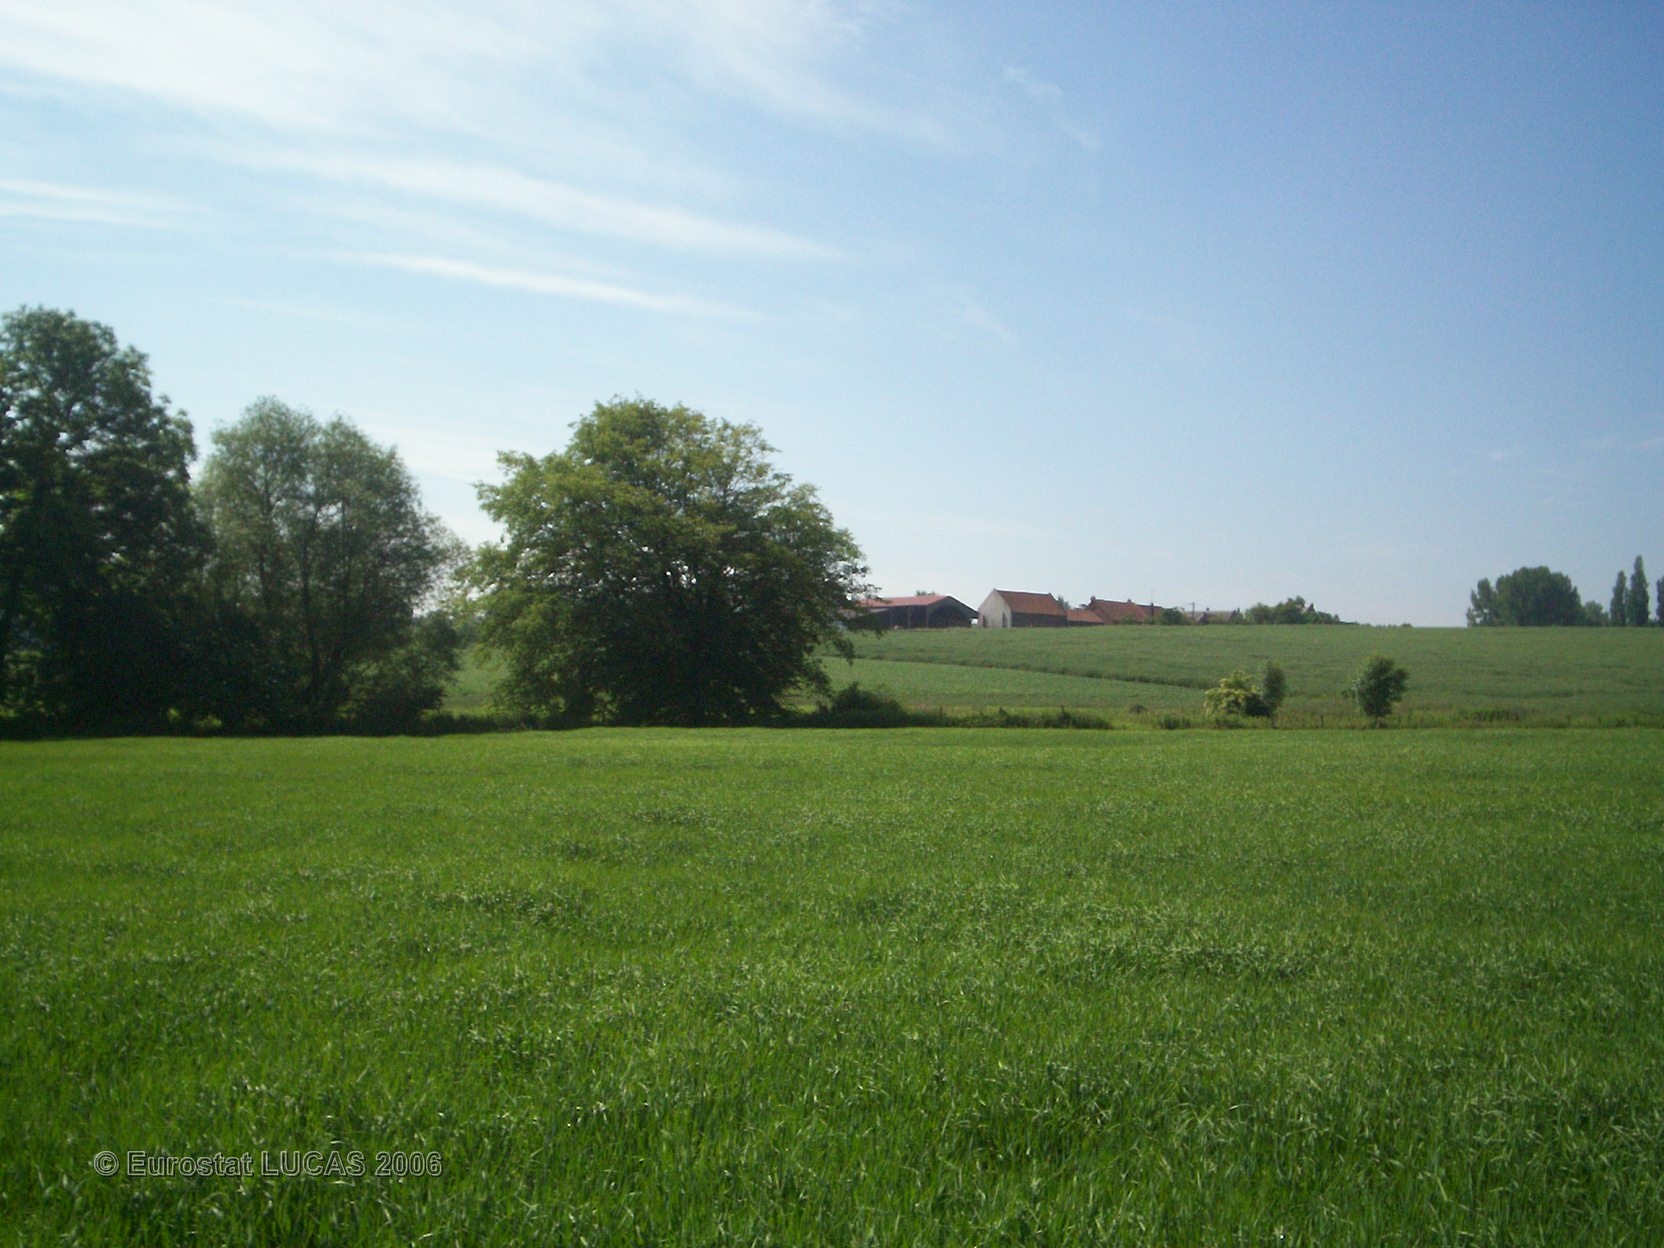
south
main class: Cropland
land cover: Oats
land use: Agriculture (excluding fallow land and kitchen gardens)
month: June
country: FR
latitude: 49.6086
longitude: 2.7238
